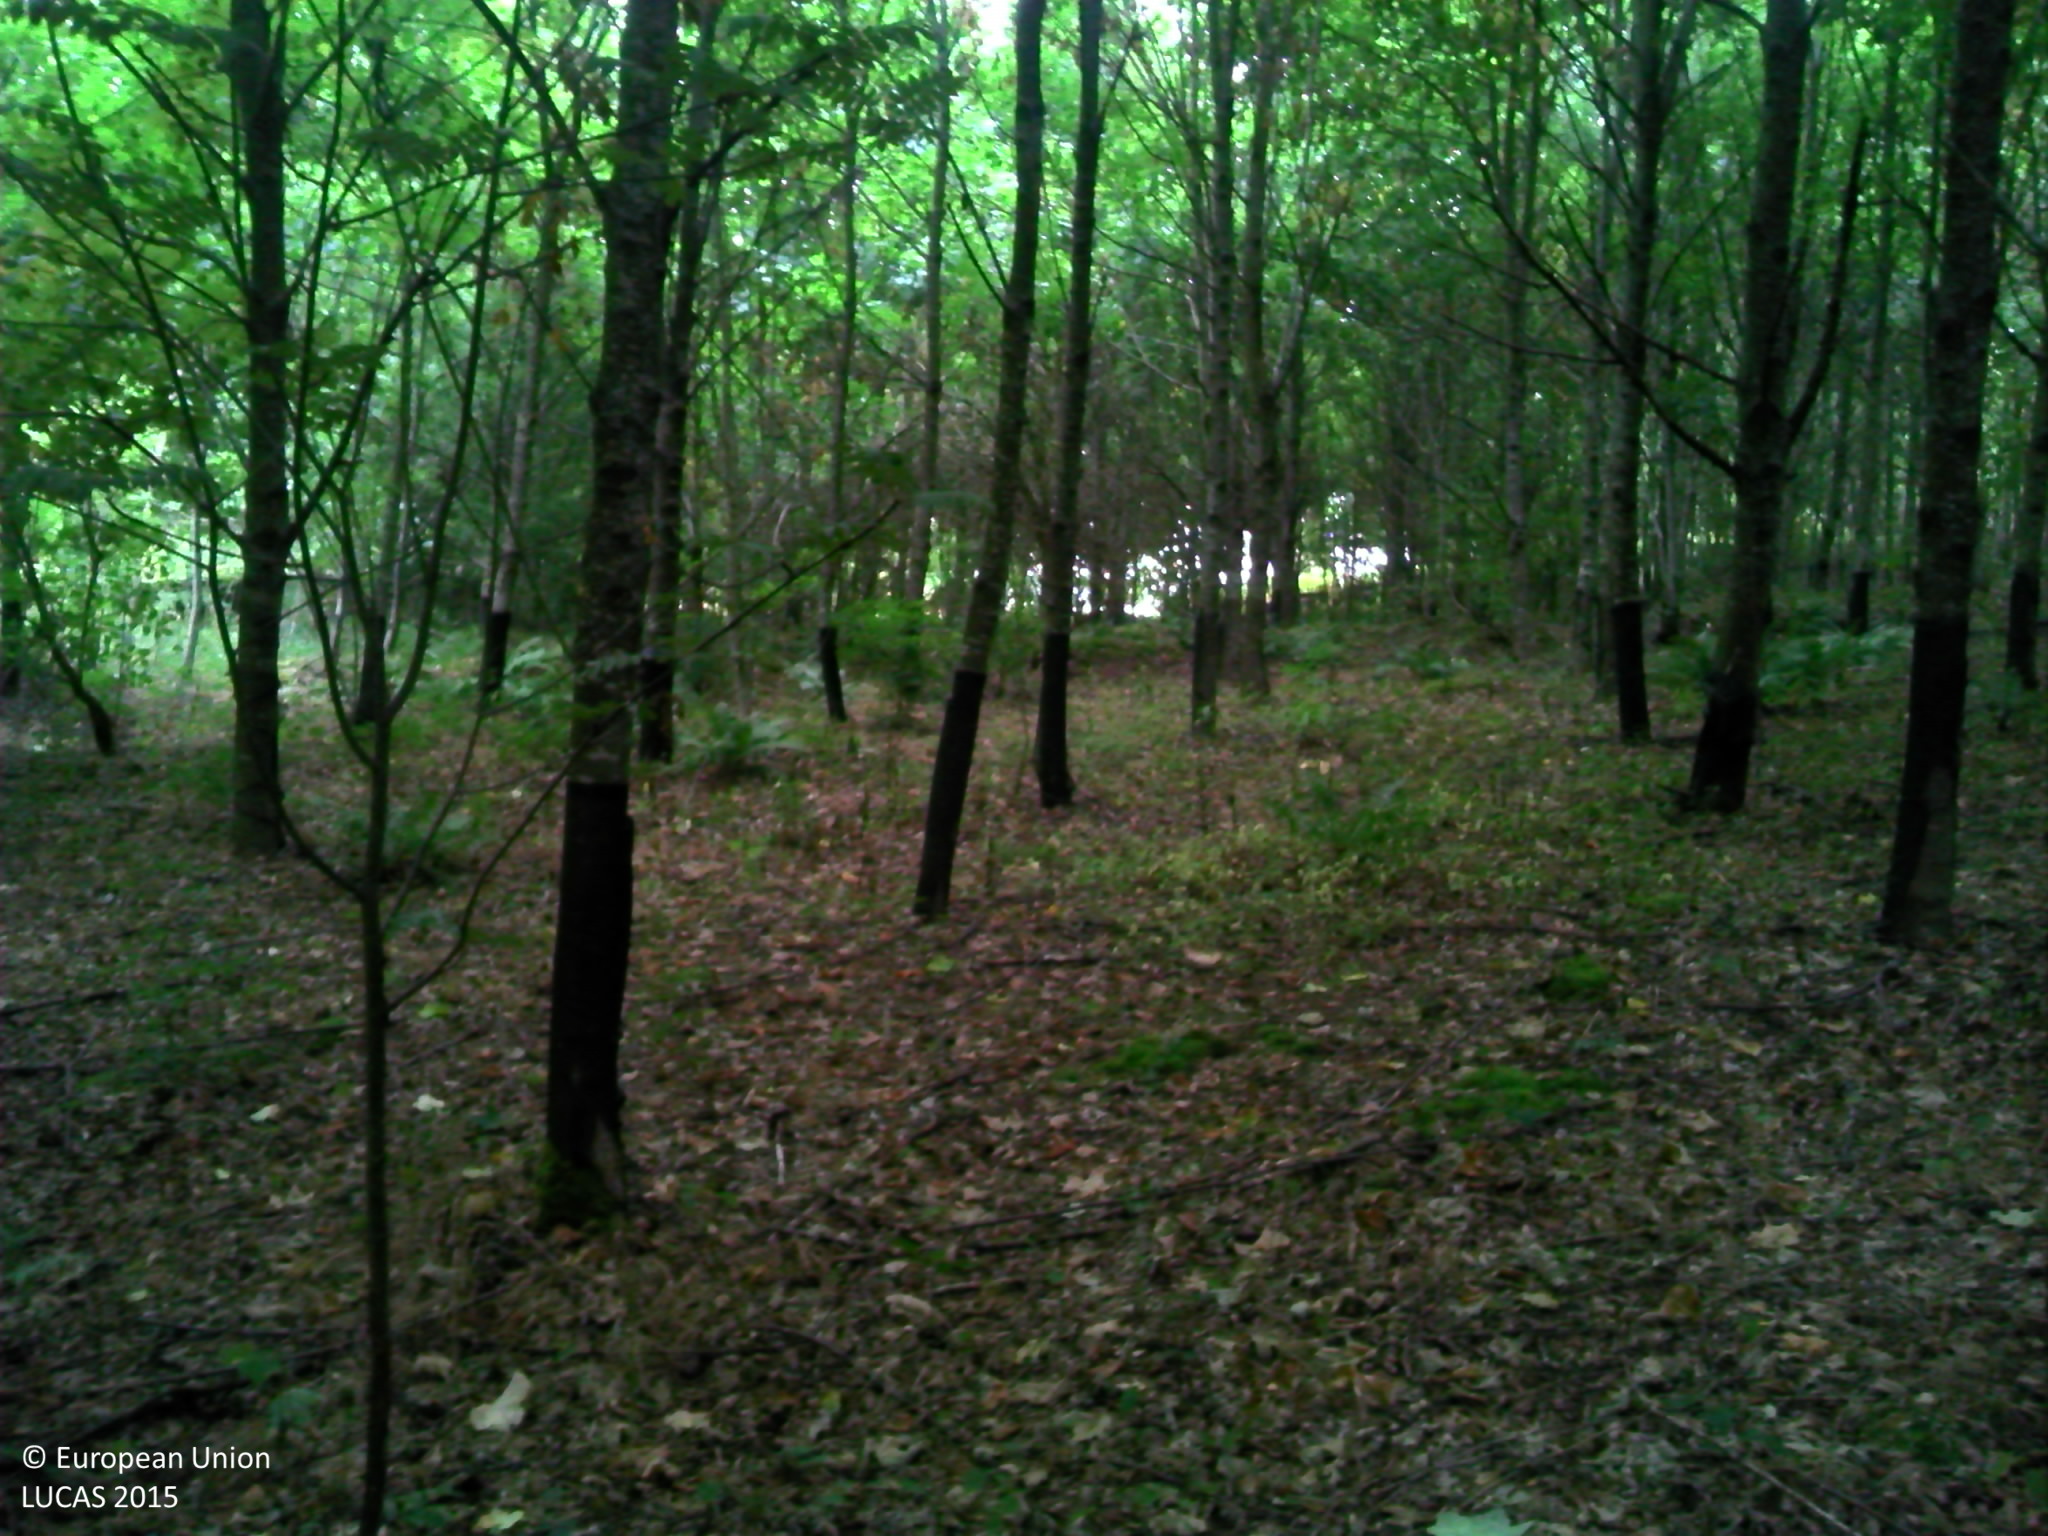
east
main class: Woodland
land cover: Broadleaved woodland
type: exotic forest
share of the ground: > 75 %
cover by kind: broadleaved forest trees 90 %, herbaceous plants 5 %
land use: Forestry
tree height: > 5 m
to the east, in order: Broadleaved woodland; Grass margins; Paved roads, cycling and walking lanes; Grass margins; Ditches and canals; Broadleaved woodland; Grass margins; Paved roads, cycling and walking lanes; Spontaneously vegetated surfaces; Other bare soil; Paved roads, cycling and walking lanes; Grass margins; Spruce dominated mixed woodland; Dry stone walls; Pine dominated mixed woodland; Dry stone walls; Tracks
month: August
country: FR
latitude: 44.9119
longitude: 4.5462
